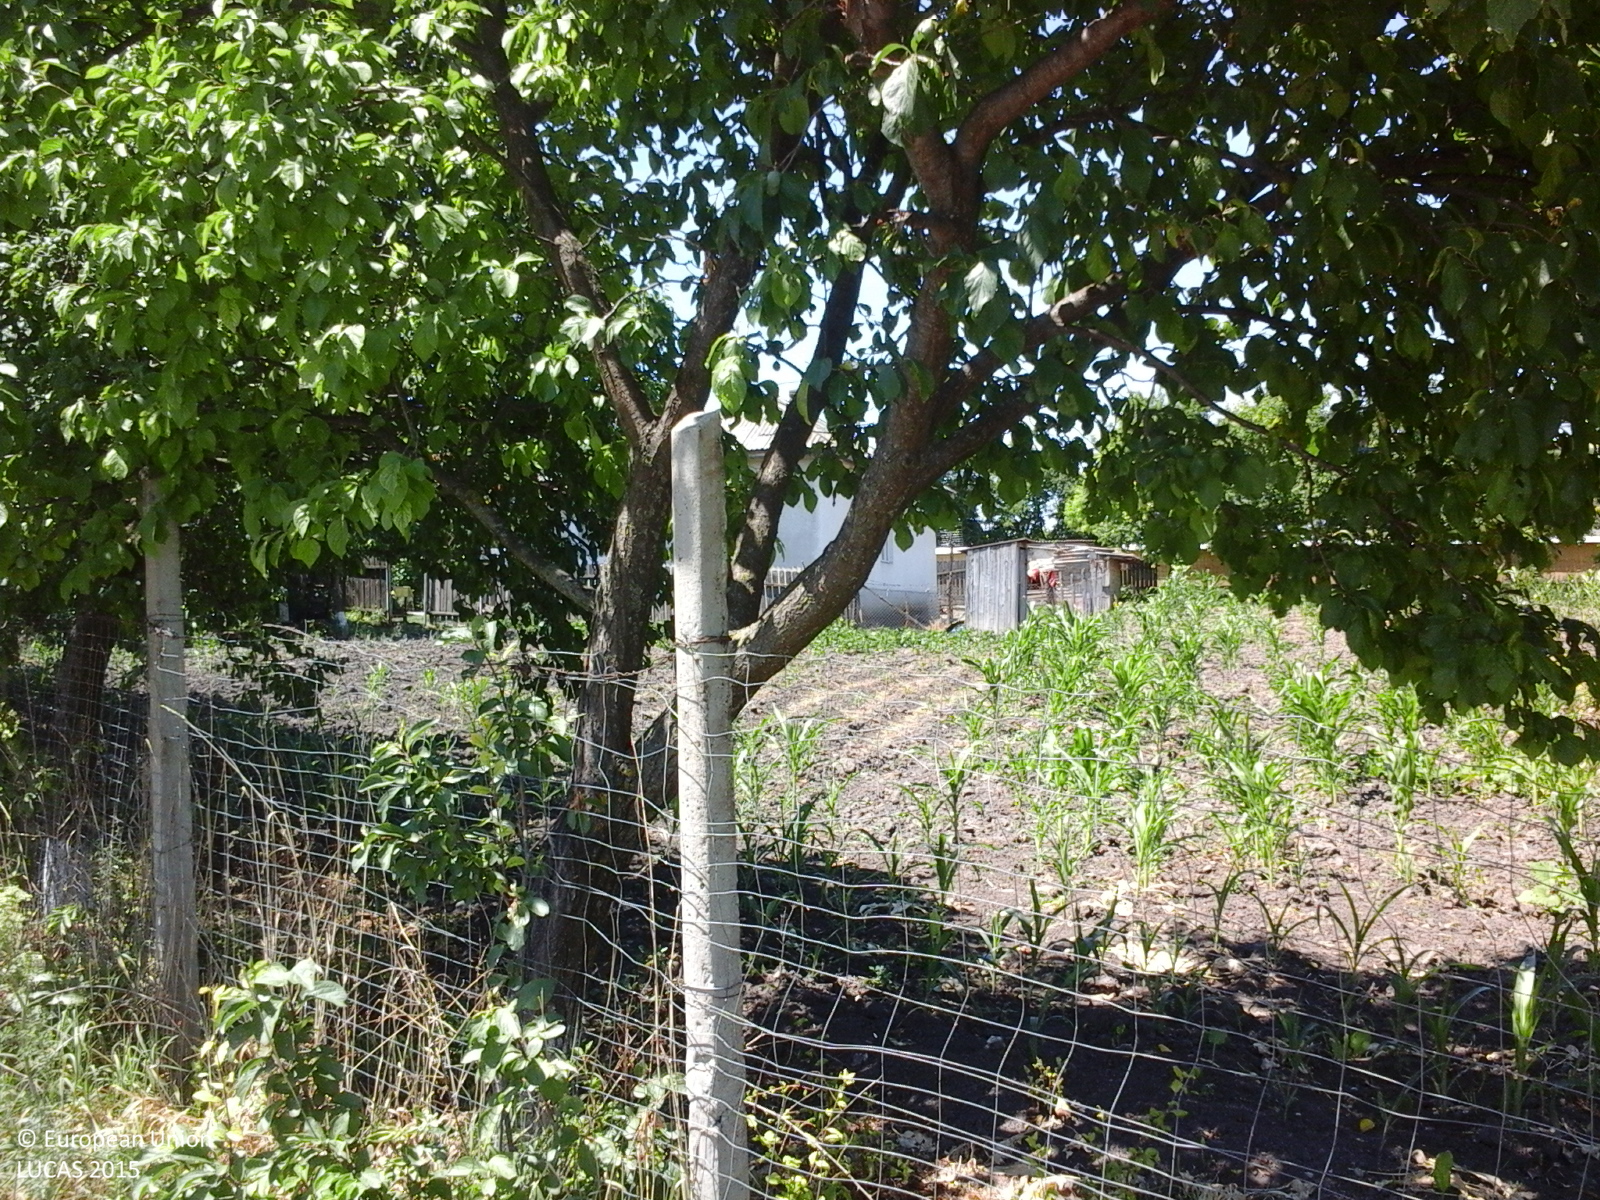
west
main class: Cropland
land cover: Maize
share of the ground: 25 - 50 %
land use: Agriculture (excluding fallow land and kitchen gardens)
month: June
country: RO
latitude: 47.2306
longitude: 26.9397
